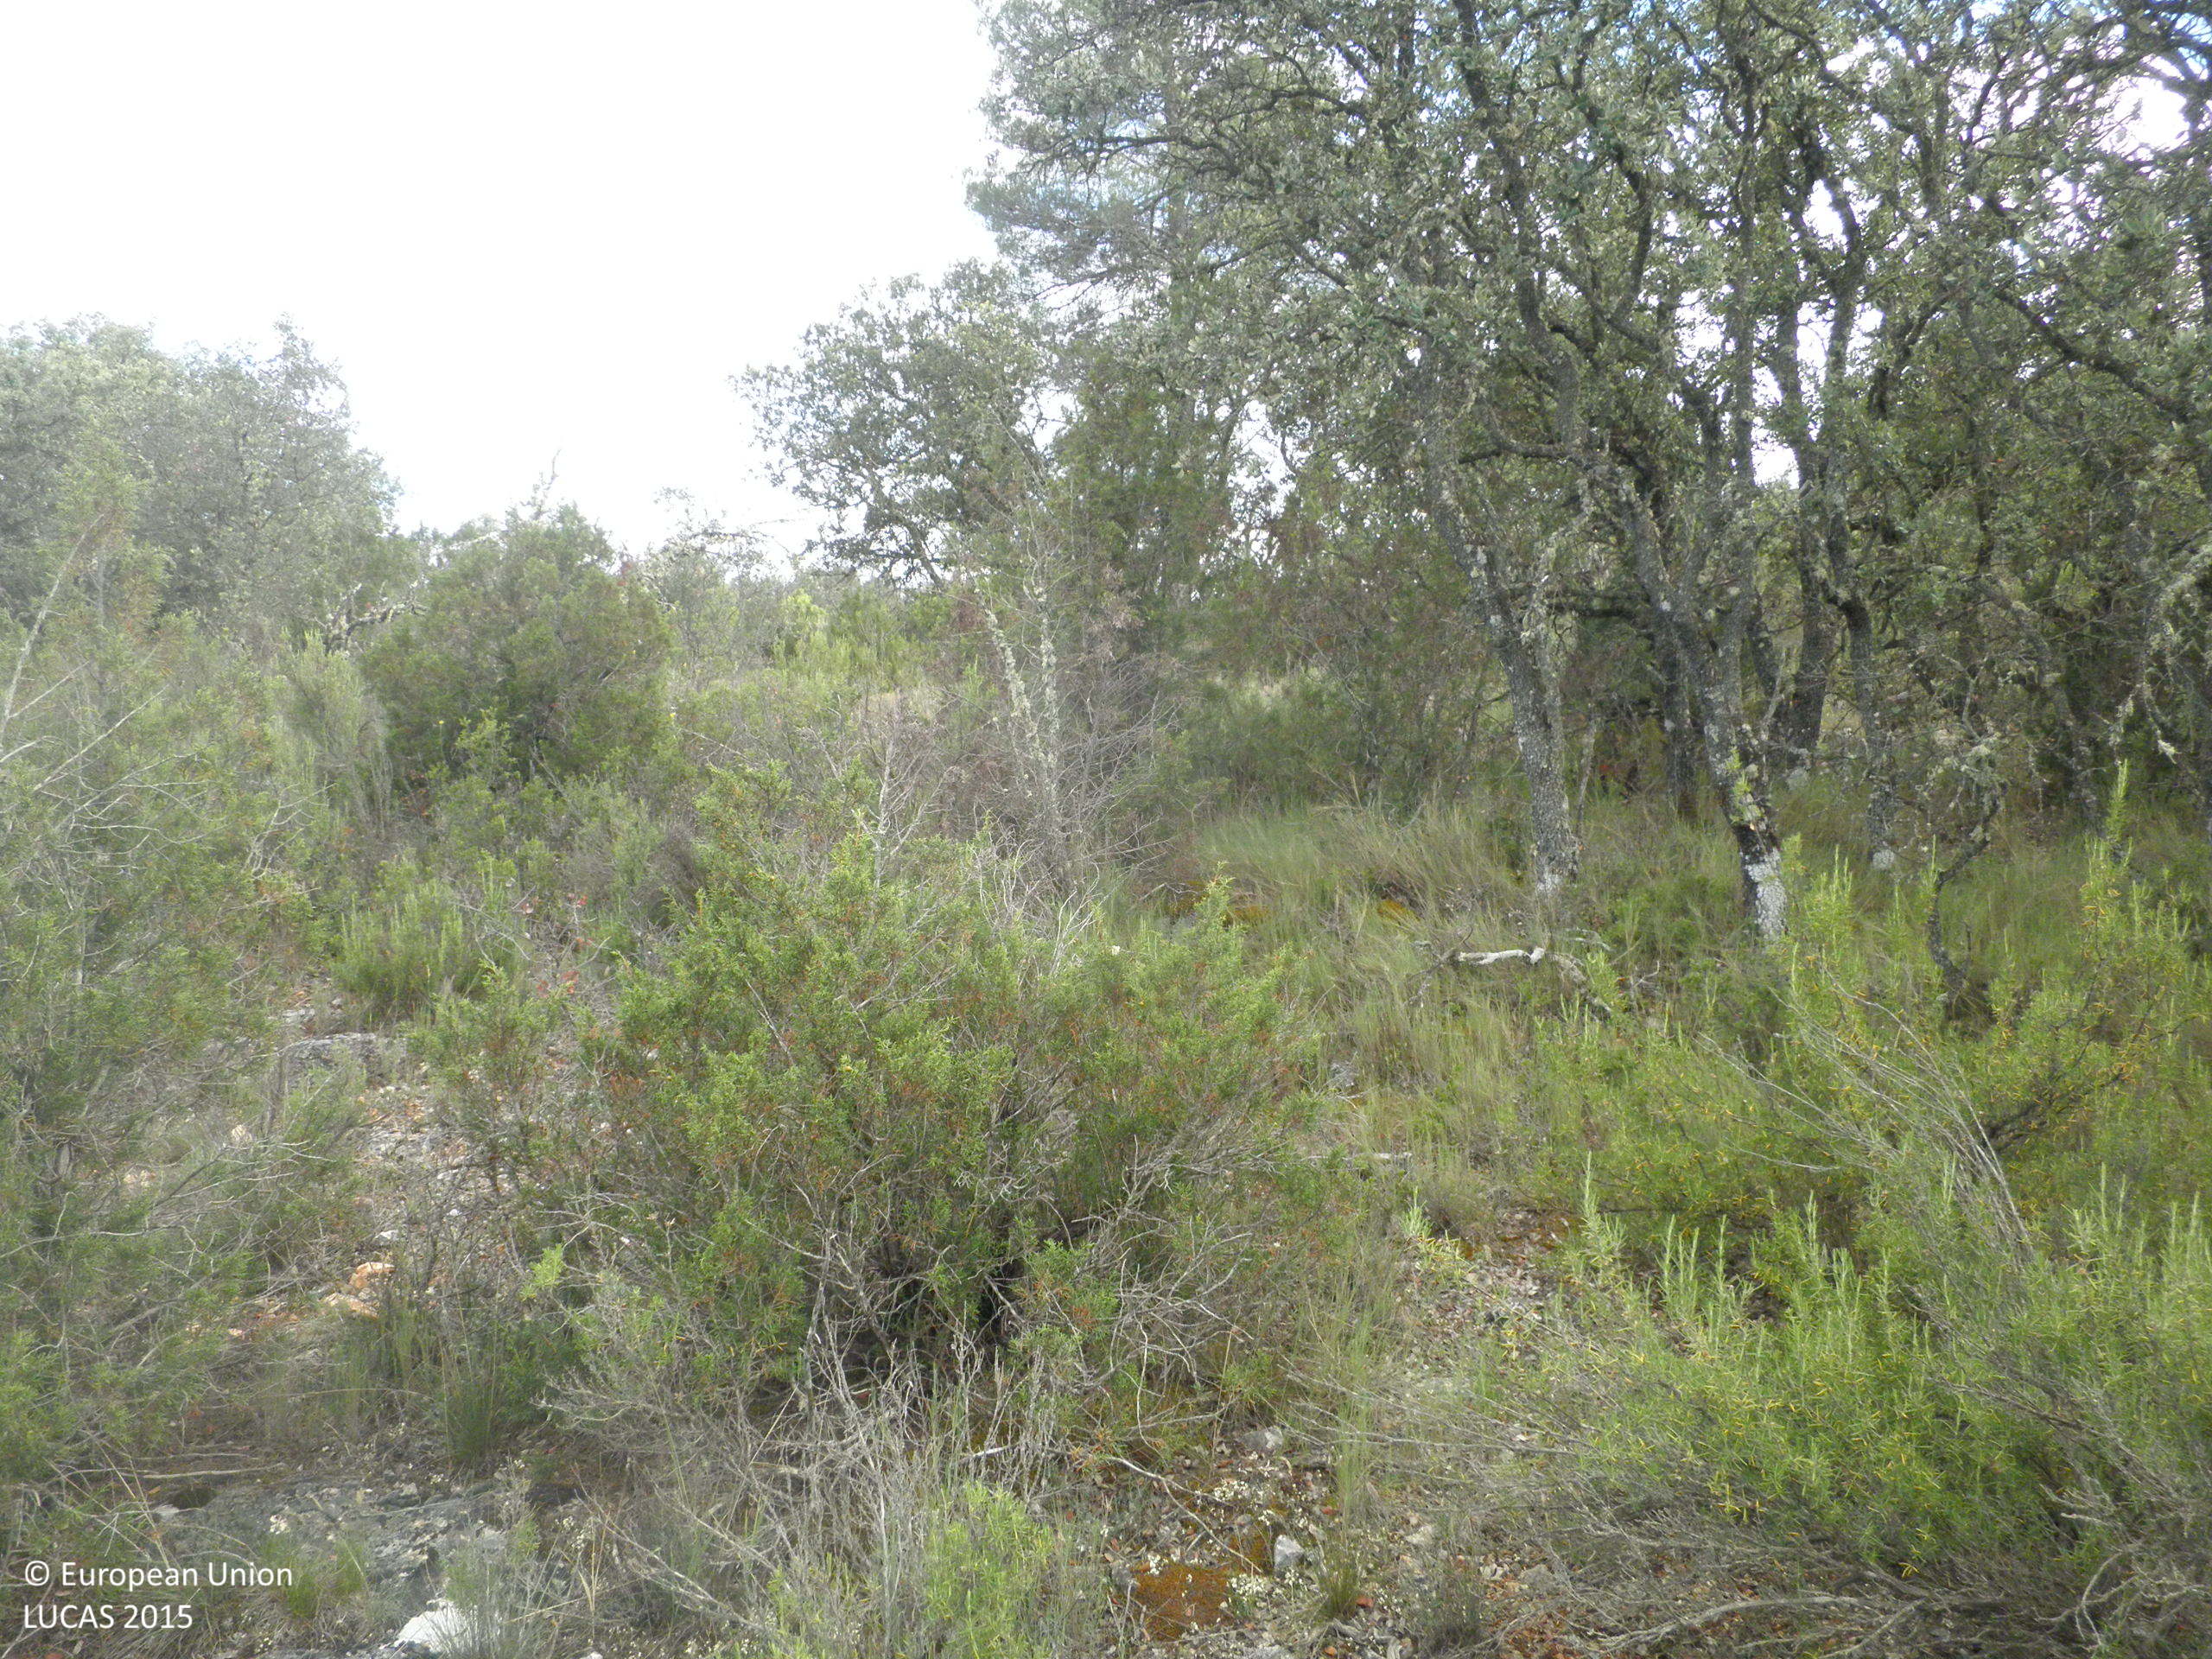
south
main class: Woodland
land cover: Broadleaved woodland
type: broadleaved evergreen forest
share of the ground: 10 - 25 %
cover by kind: shrubs 40 %, unconsolidated bare surface 30 %, broadleaved forest trees 20 %, herbaceous plants 10 %
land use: Semi-natural and natural areas not in use
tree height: < 5 m
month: June
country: ES
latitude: 39.7334
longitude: -1.6643
